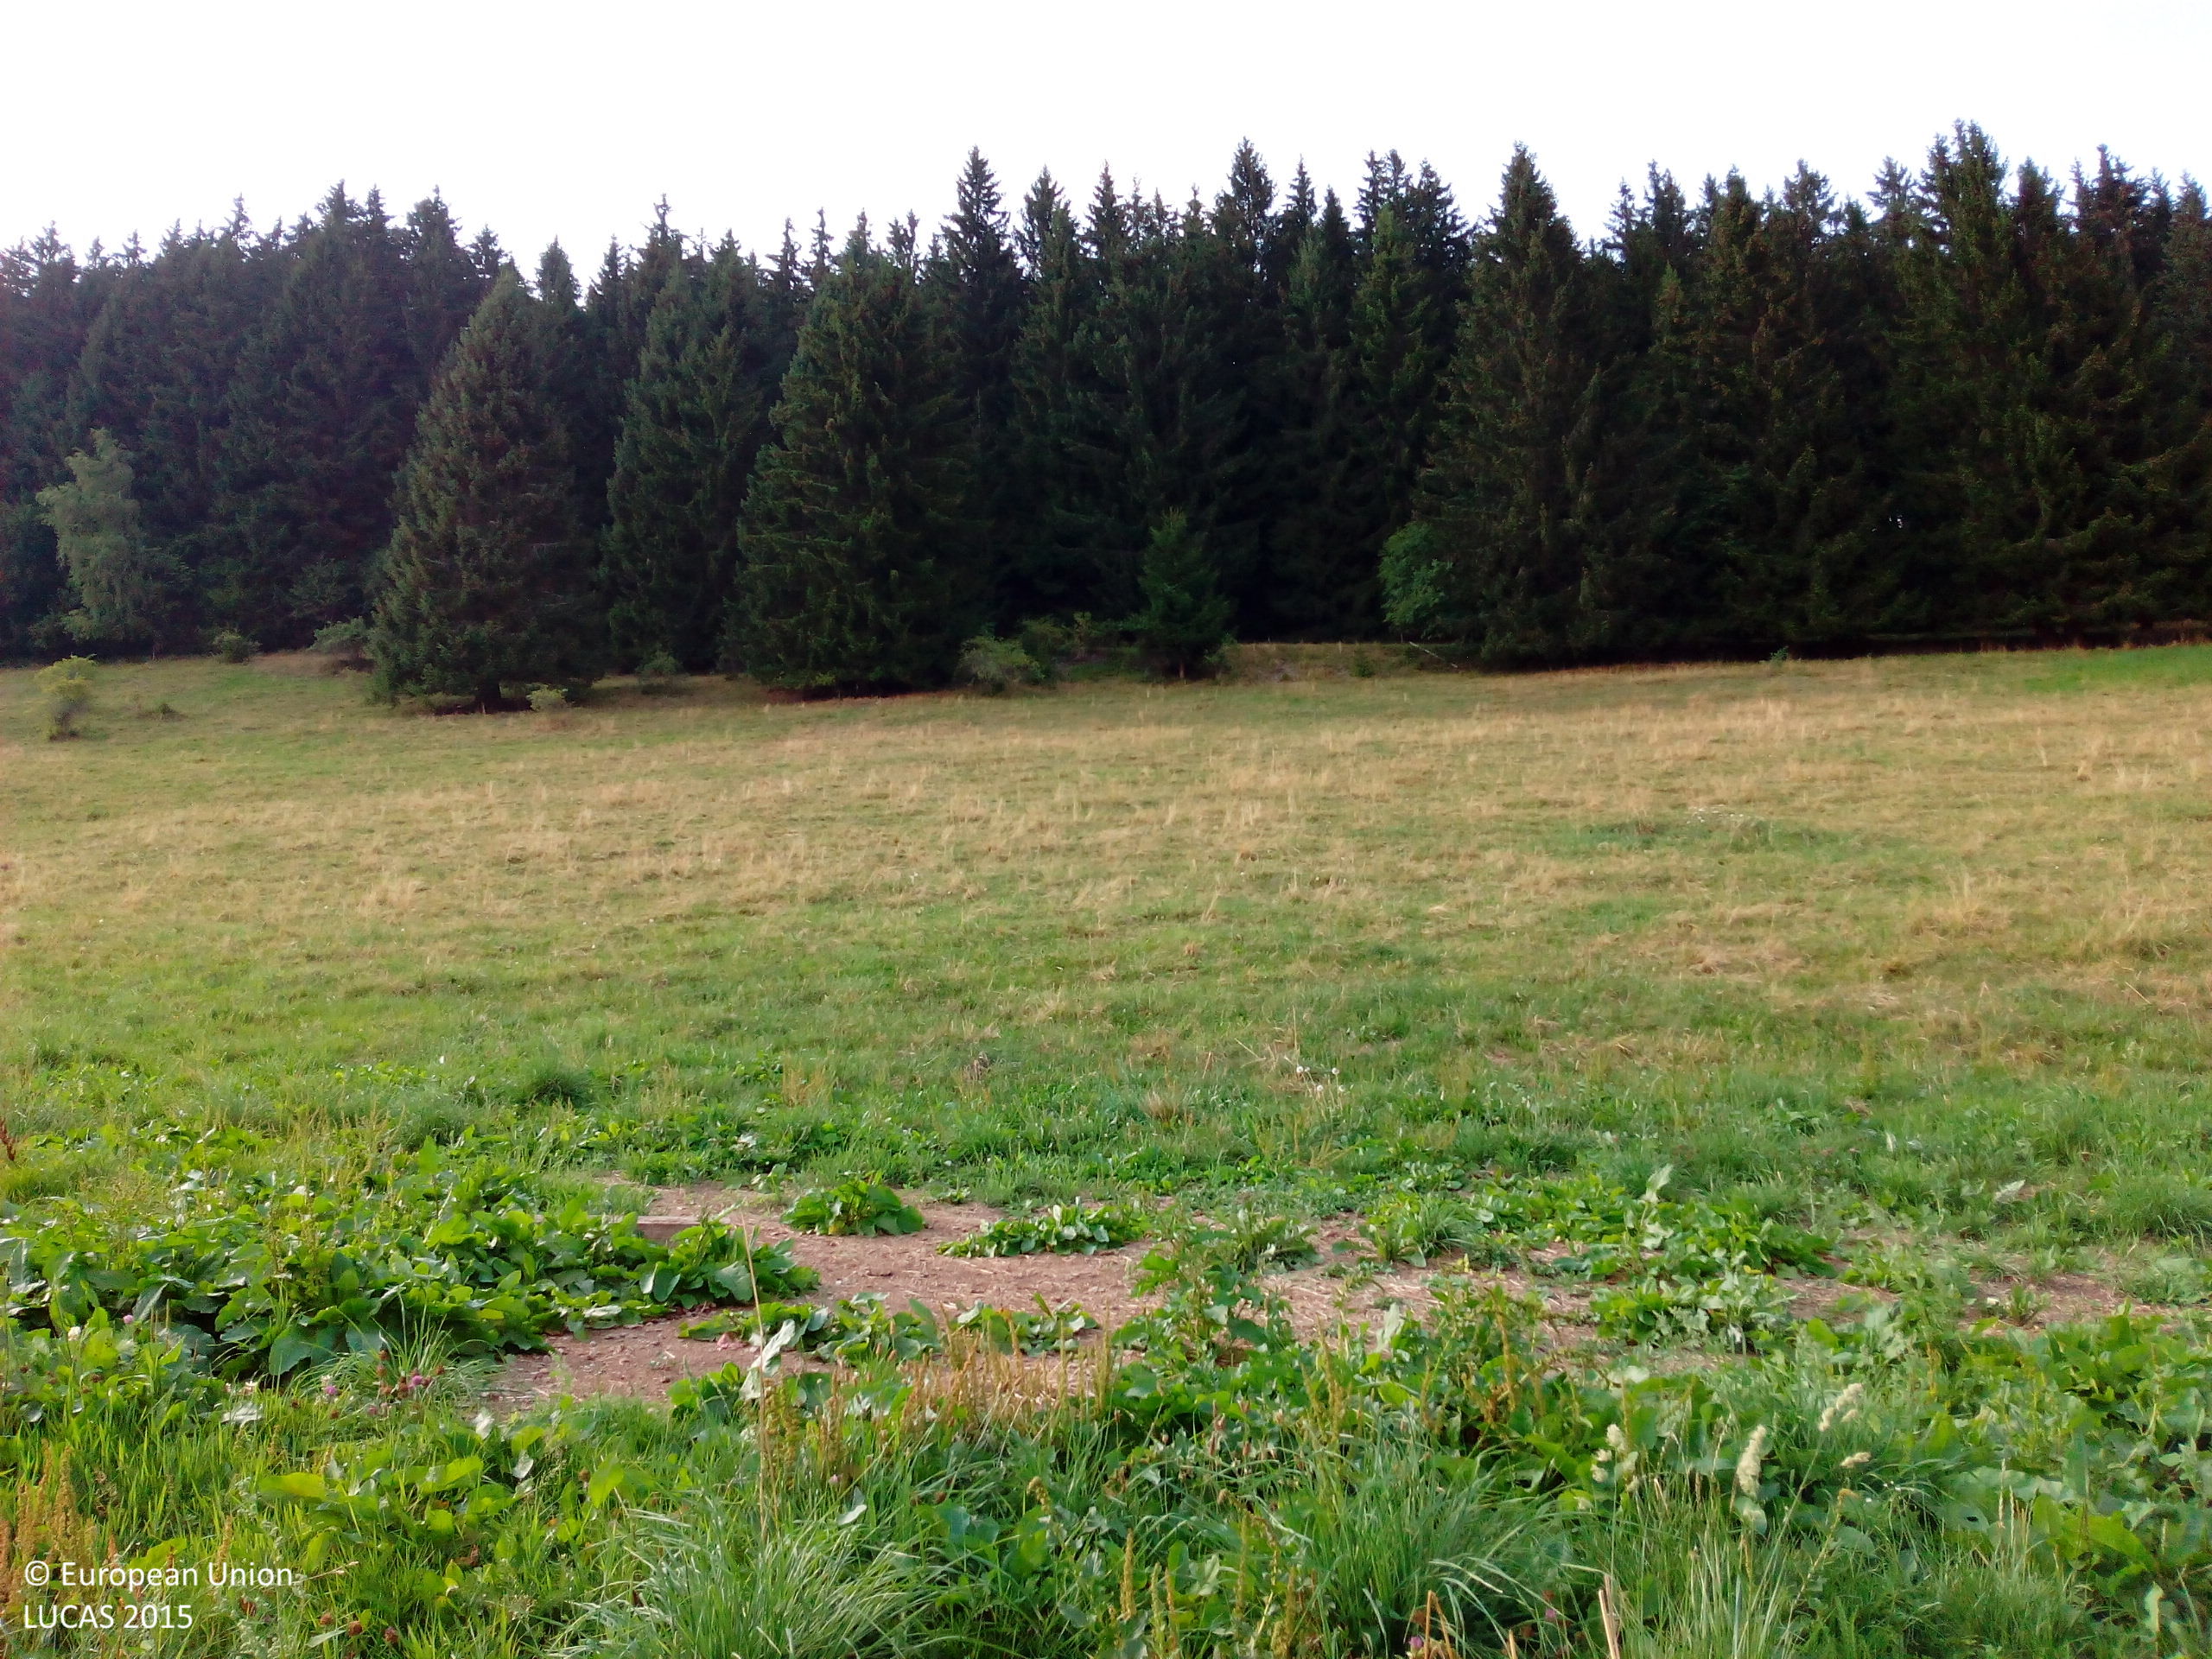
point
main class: Grassland
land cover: Grassland without tree/shrub cover
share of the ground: > 75 %
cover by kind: herbaceous plants 100 %
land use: Agriculture (excluding fallow land and kitchen gardens)
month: August
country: DE
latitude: 47.8659
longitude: 8.1430
